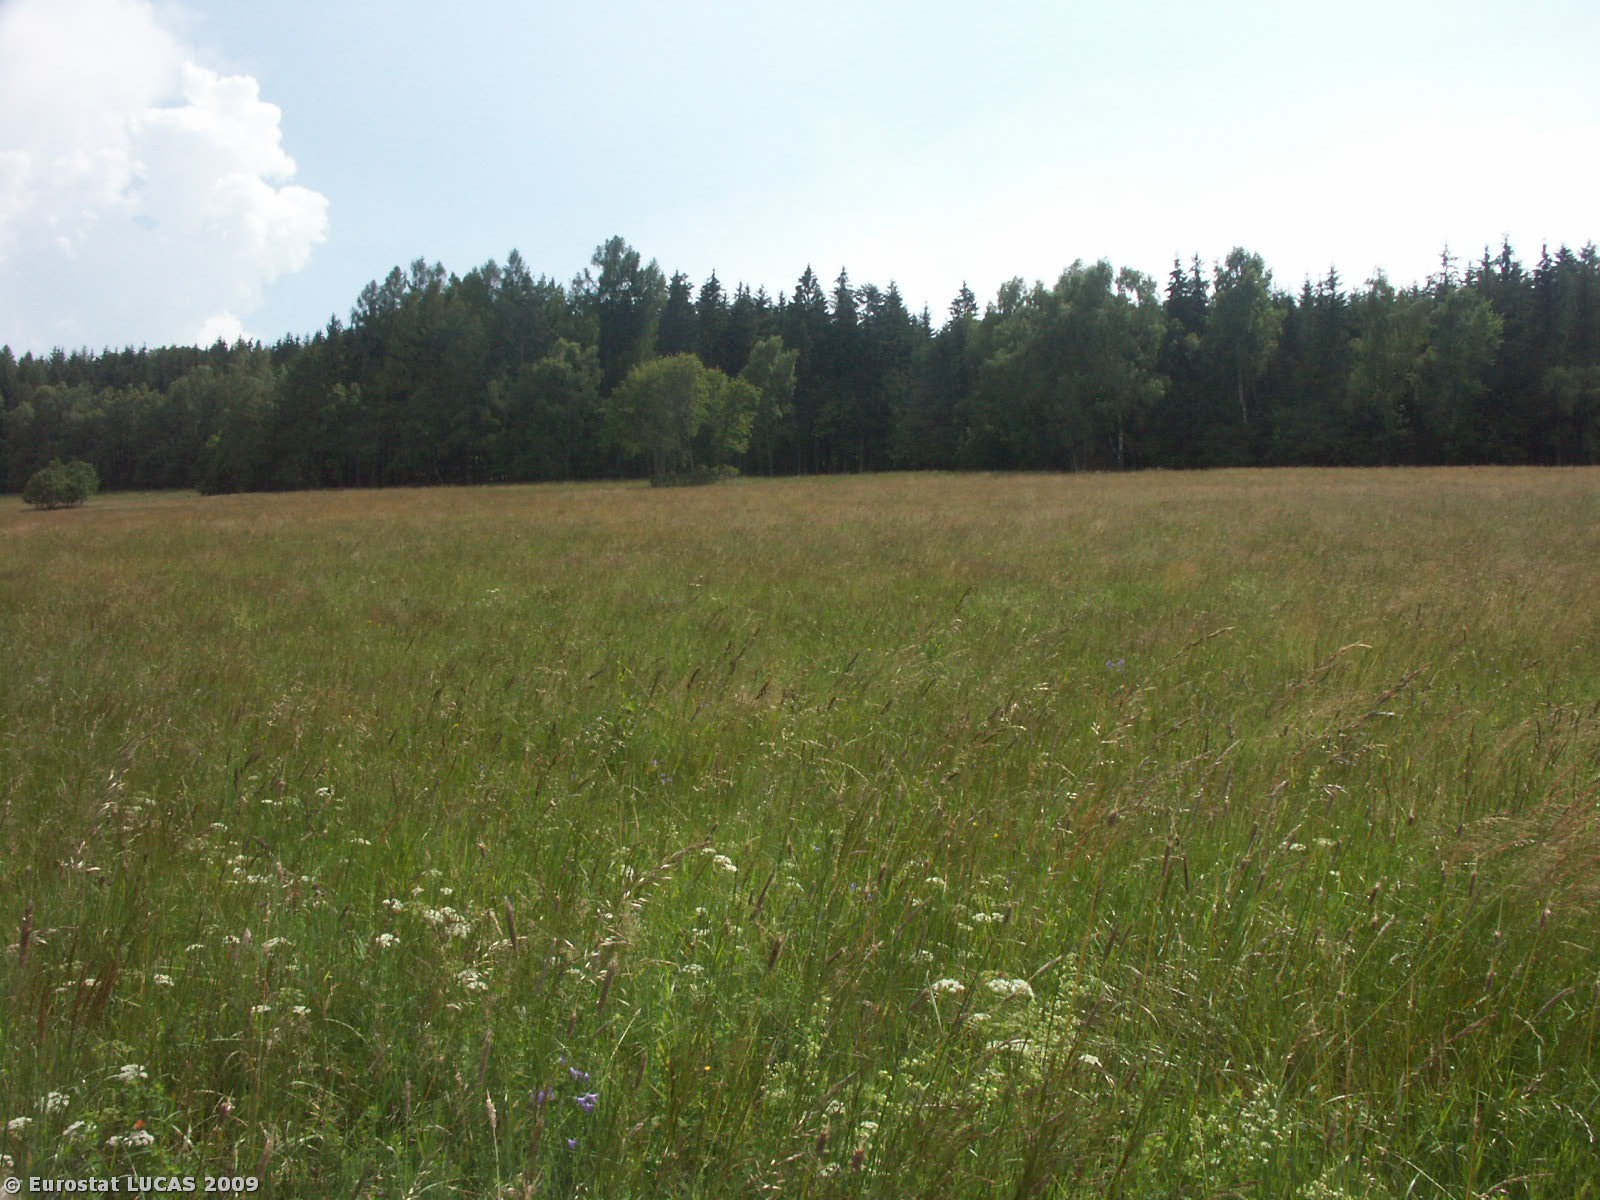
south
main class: Grassland
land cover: Grassland without tree/shrub cover
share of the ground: > 75 %
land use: Agriculture (excluding fallow land and kitchen gardens)
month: July
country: CZ
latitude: 50.0252
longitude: 16.6664
